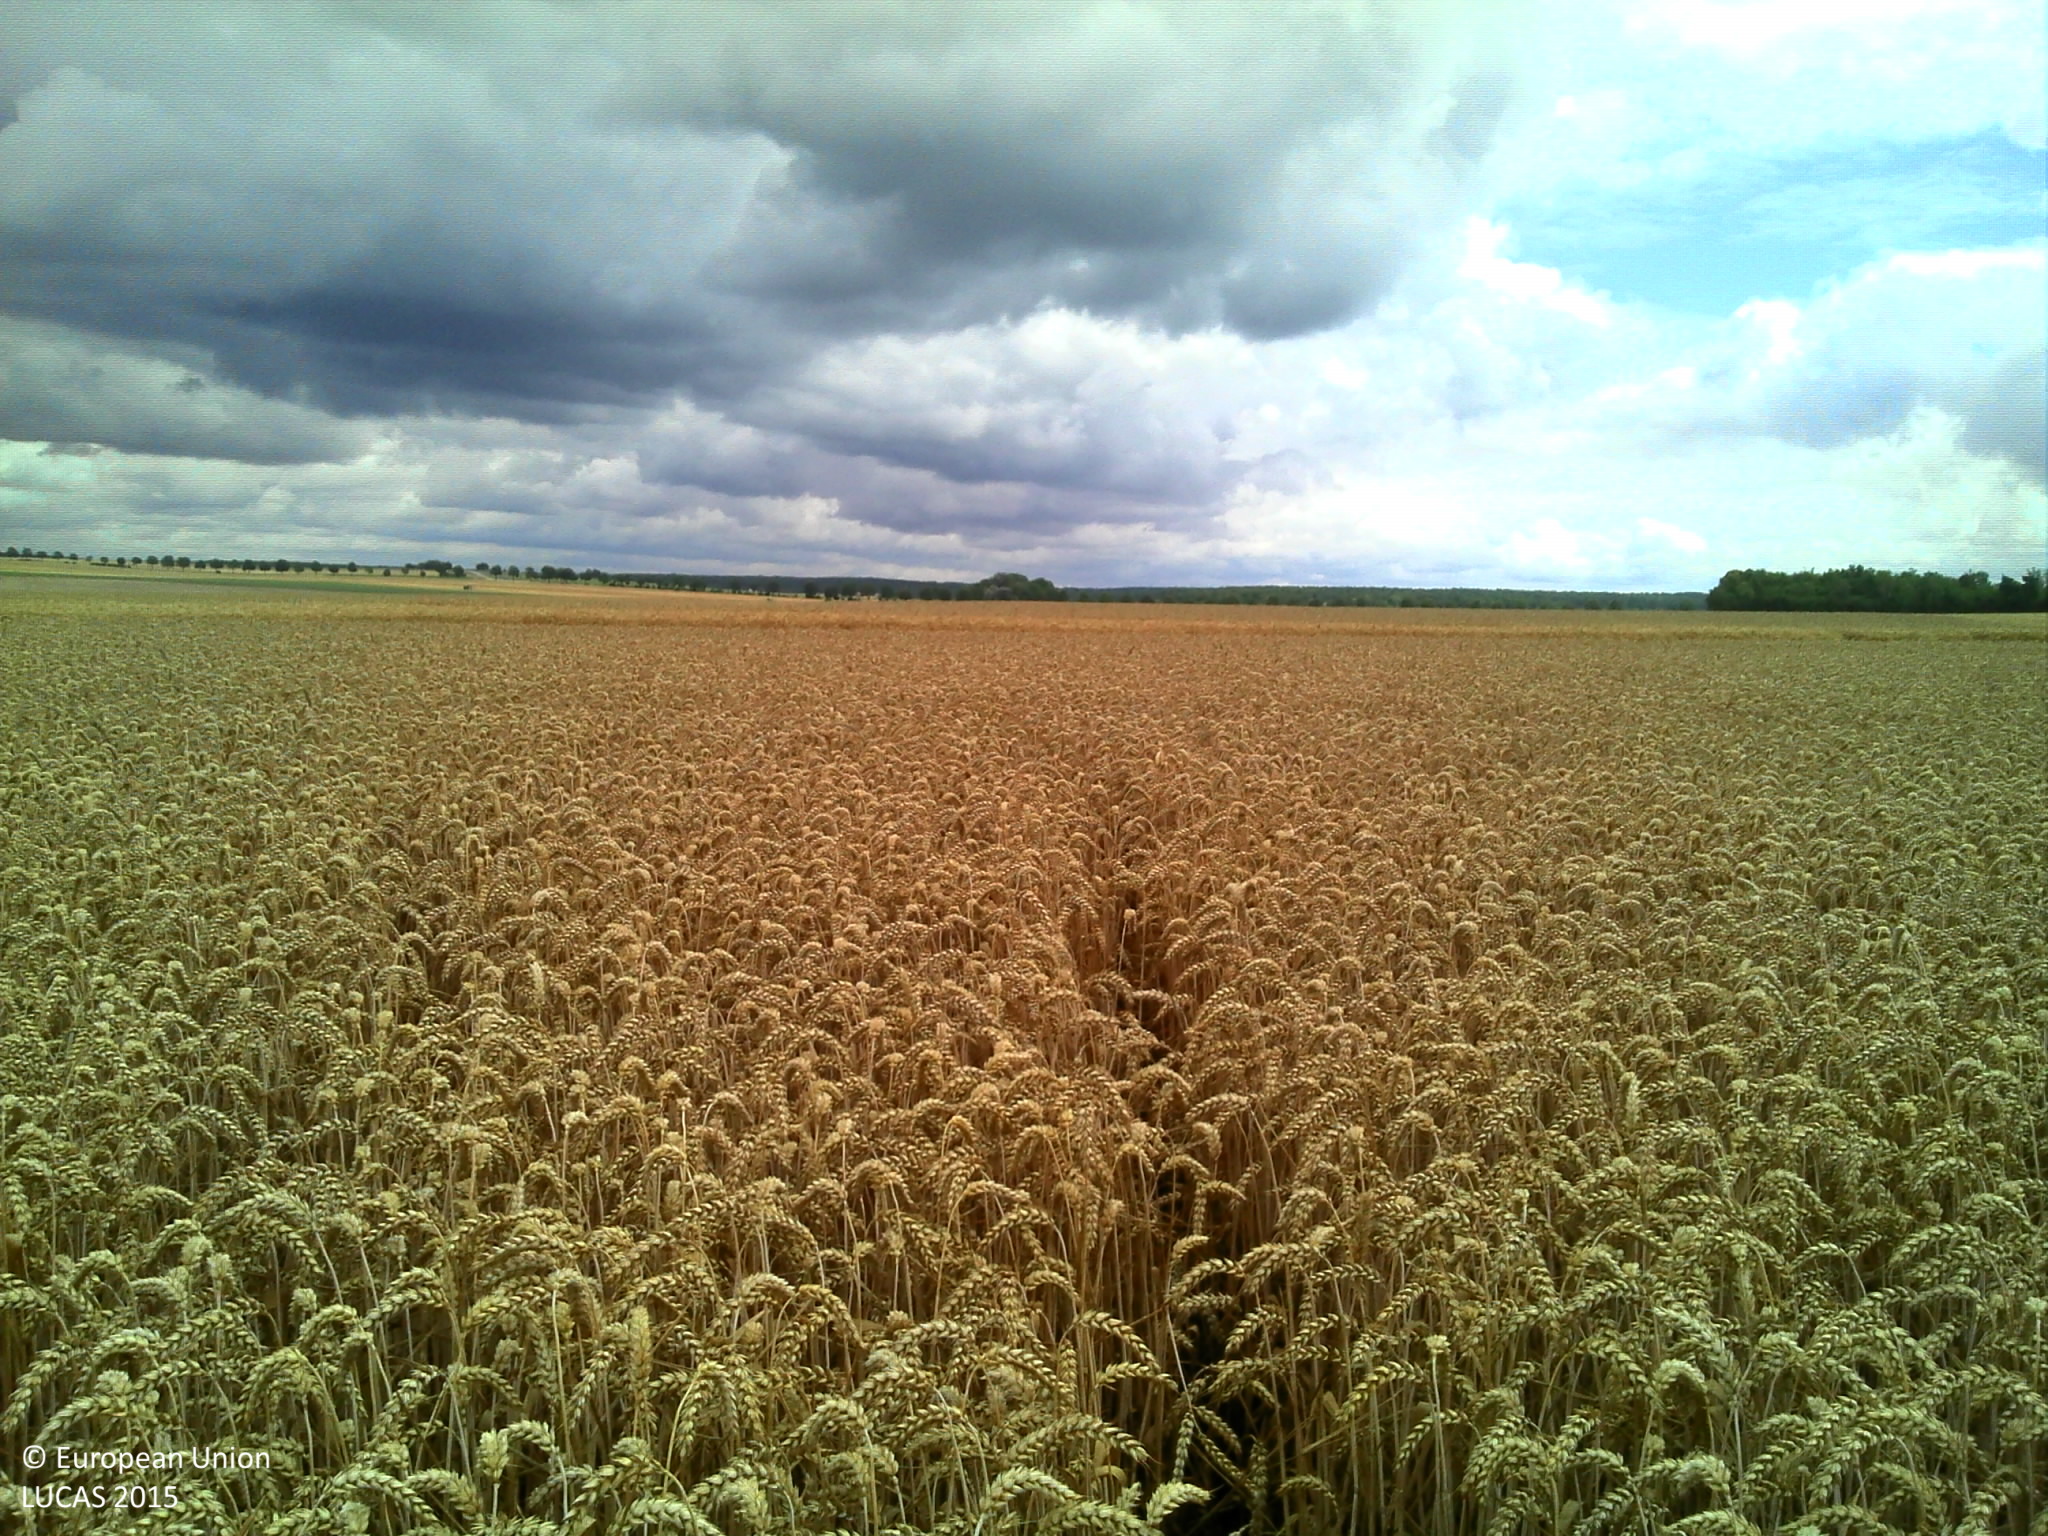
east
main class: Cropland
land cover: Common wheat
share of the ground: > 75 %
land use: Agriculture (excluding fallow land and kitchen gardens)
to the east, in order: Common wheat; Grass margins; Tracks; Grass margins; Barley
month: July
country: FR
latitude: 49.1694
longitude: 4.5241
